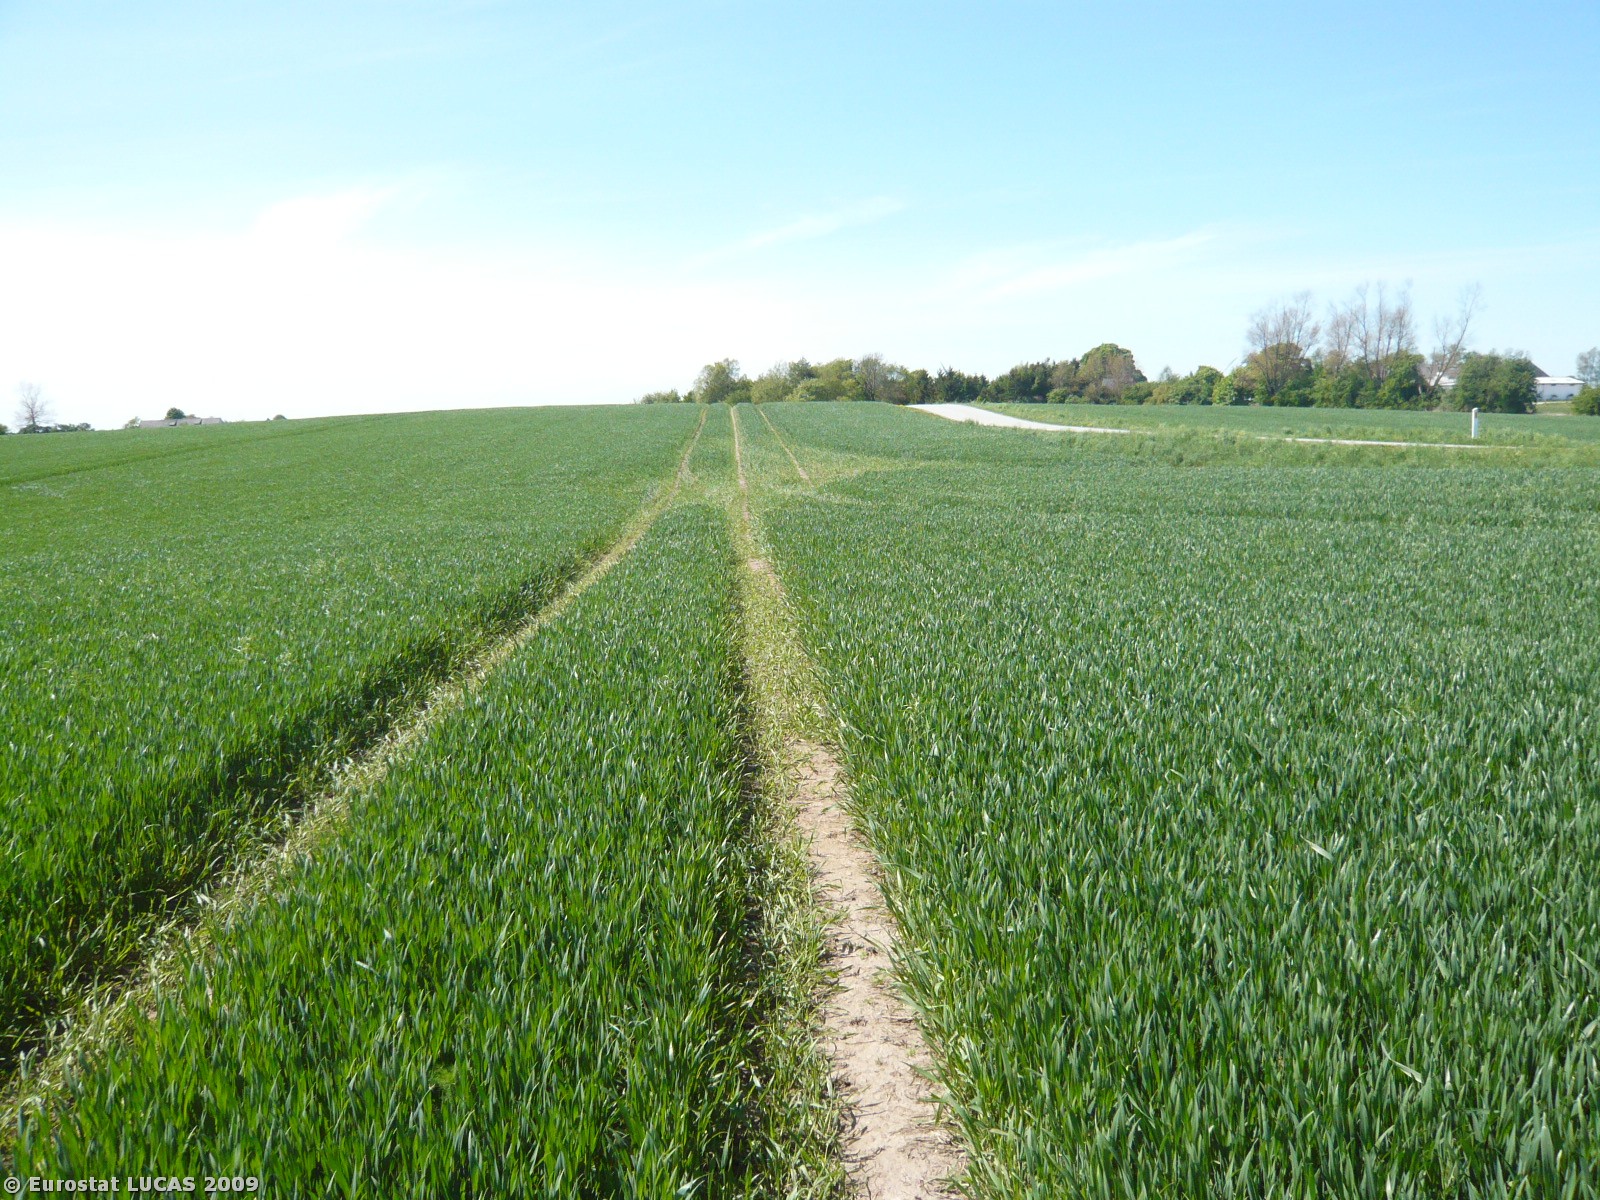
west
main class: Cropland
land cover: Common wheat
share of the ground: > 75 %
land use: Agriculture (excluding fallow land and kitchen gardens)
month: May
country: DK
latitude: 55.2383
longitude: 11.9329
